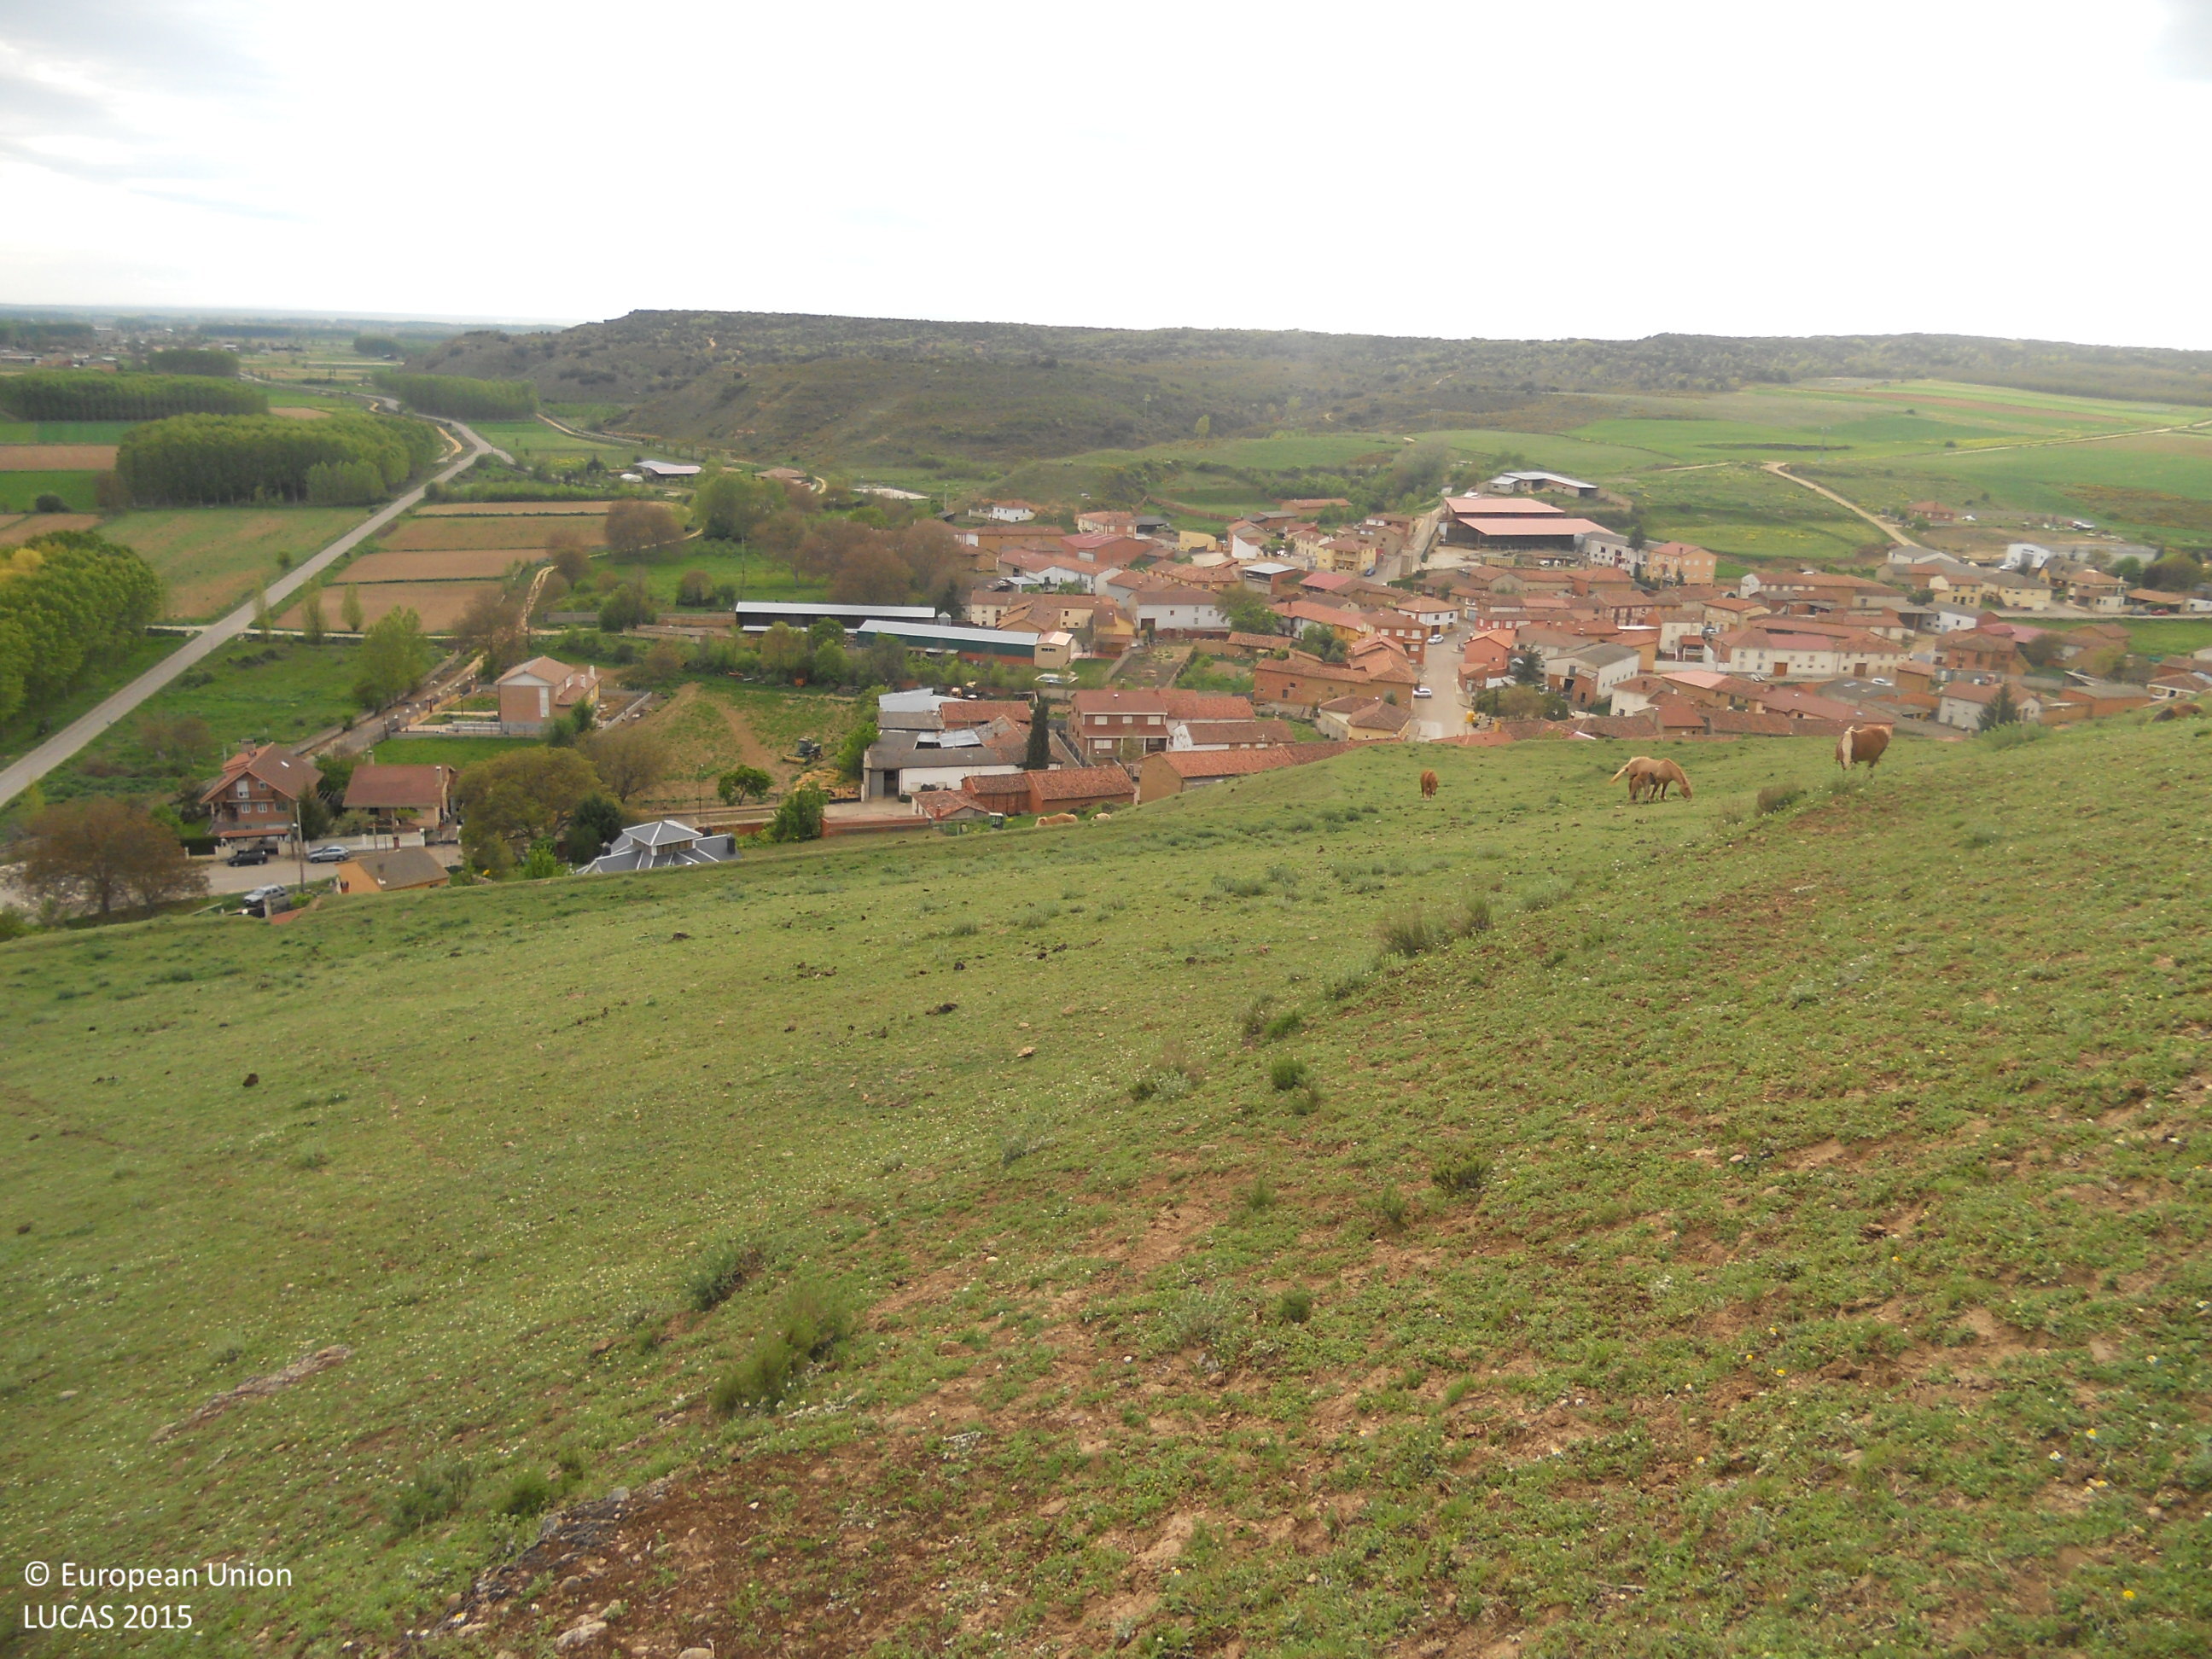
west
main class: Grassland
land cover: Grassland without tree/shrub cover
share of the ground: > 75 %
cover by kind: herbaceous plants 100 %
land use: Agriculture (excluding fallow land and kitchen gardens)
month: May
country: ES
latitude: 42.5403
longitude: -5.3488
